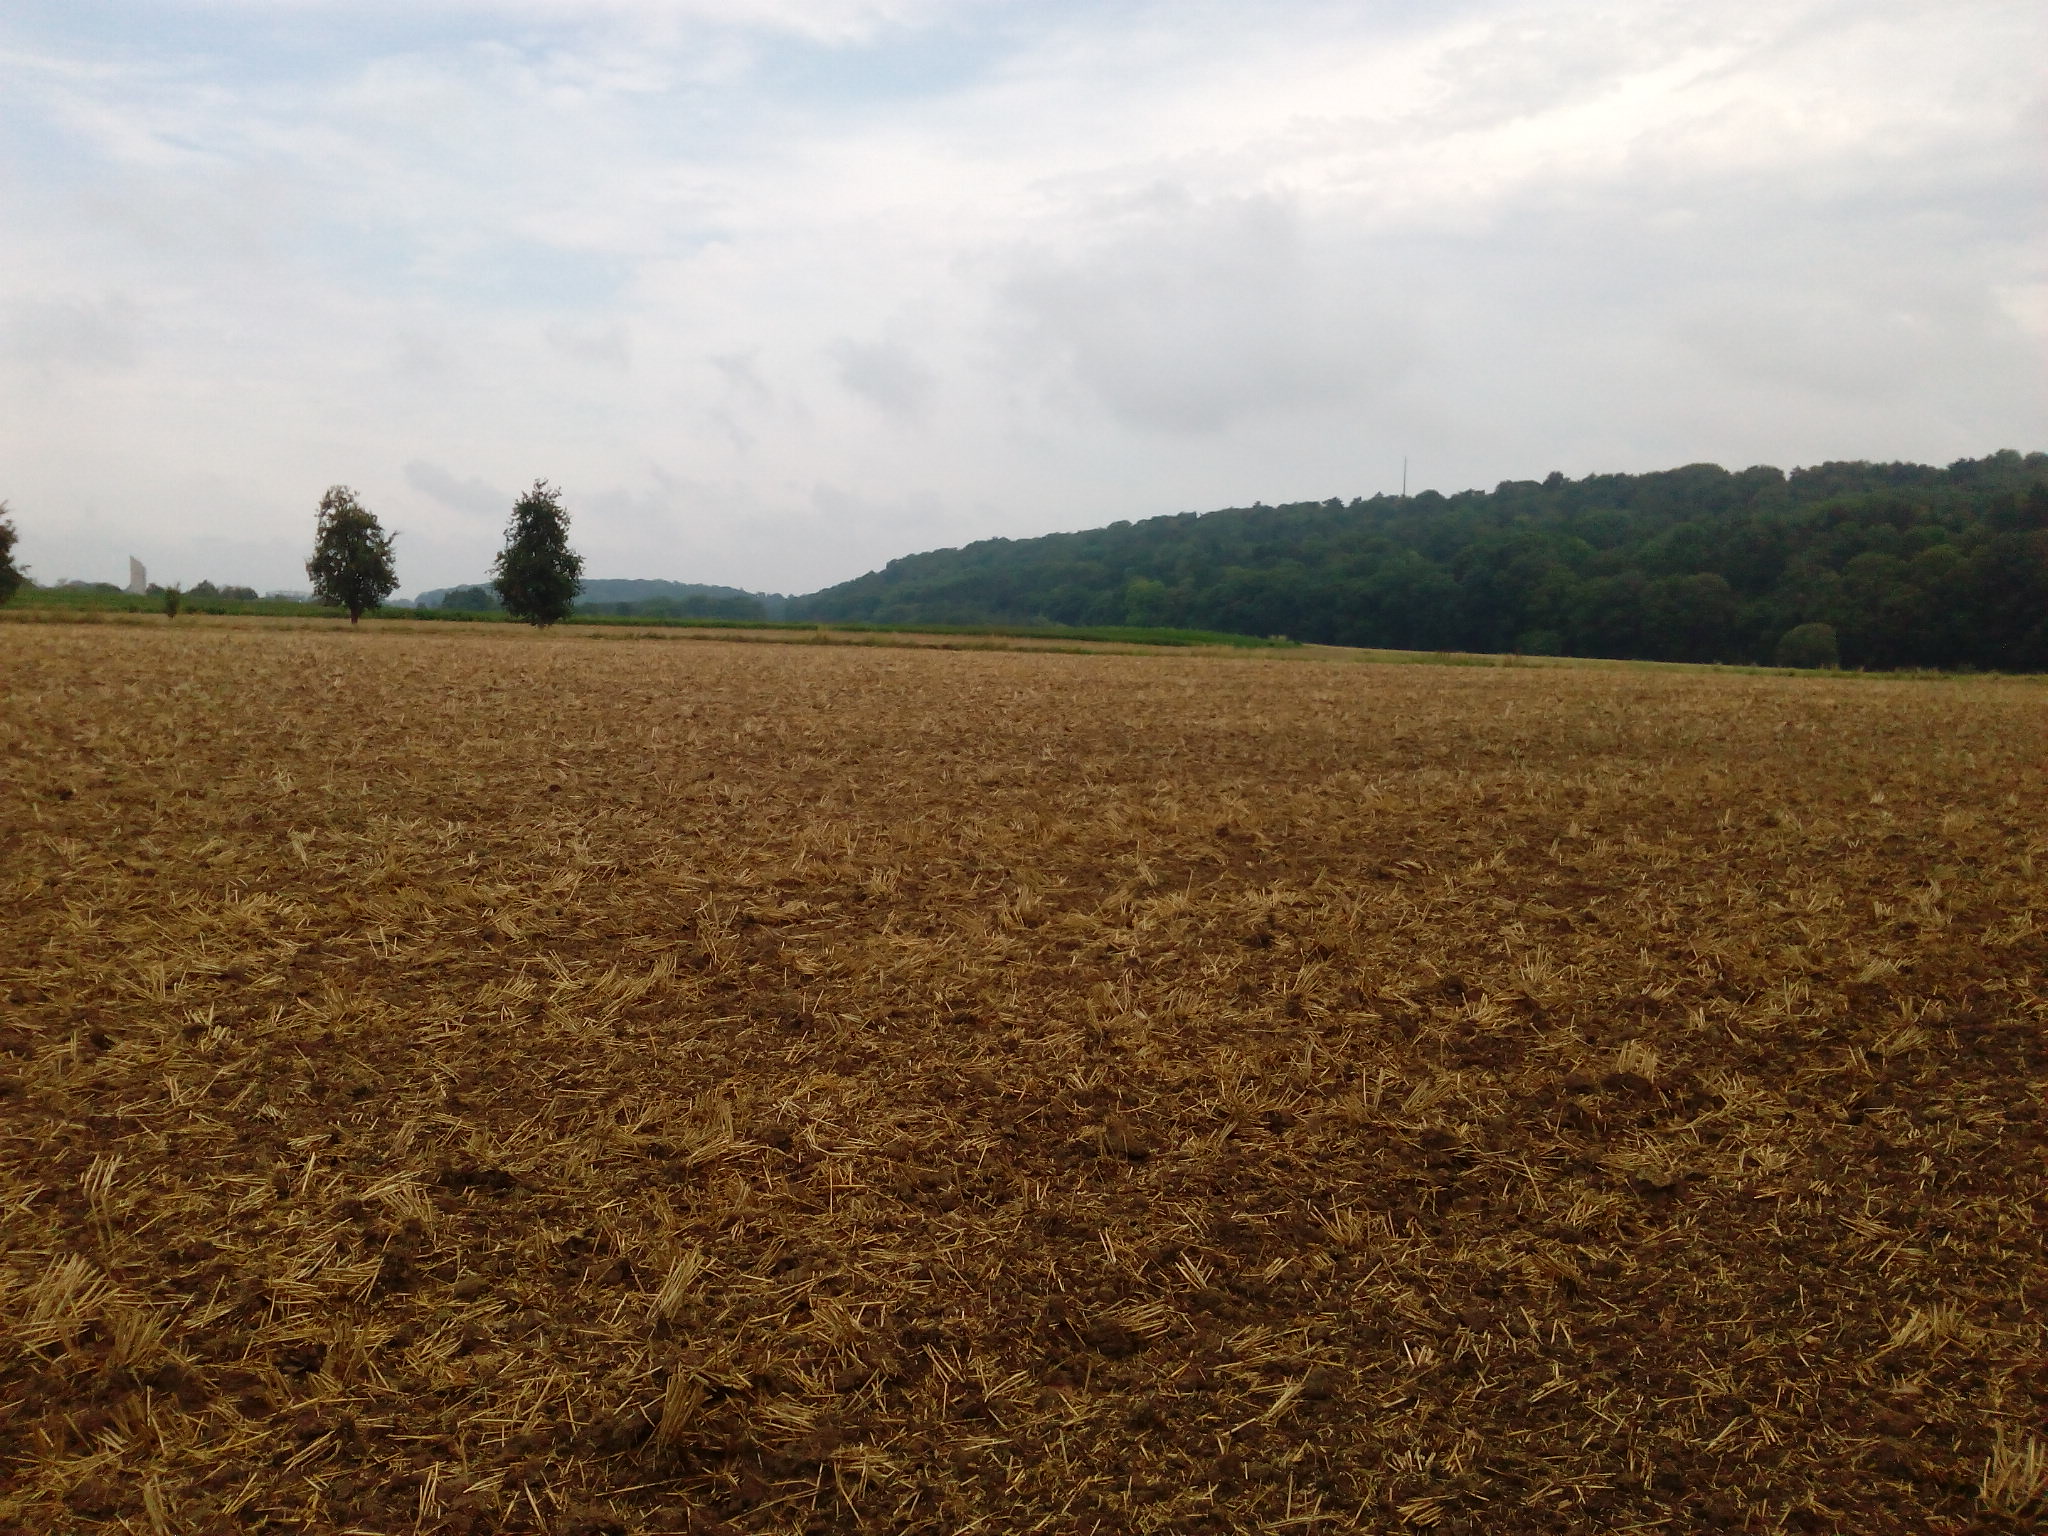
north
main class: Cropland
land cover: Common wheat
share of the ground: < 10 %
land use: Agriculture (excluding fallow land and kitchen gardens)
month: August
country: DE
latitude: 52.1258
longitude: 9.9270
